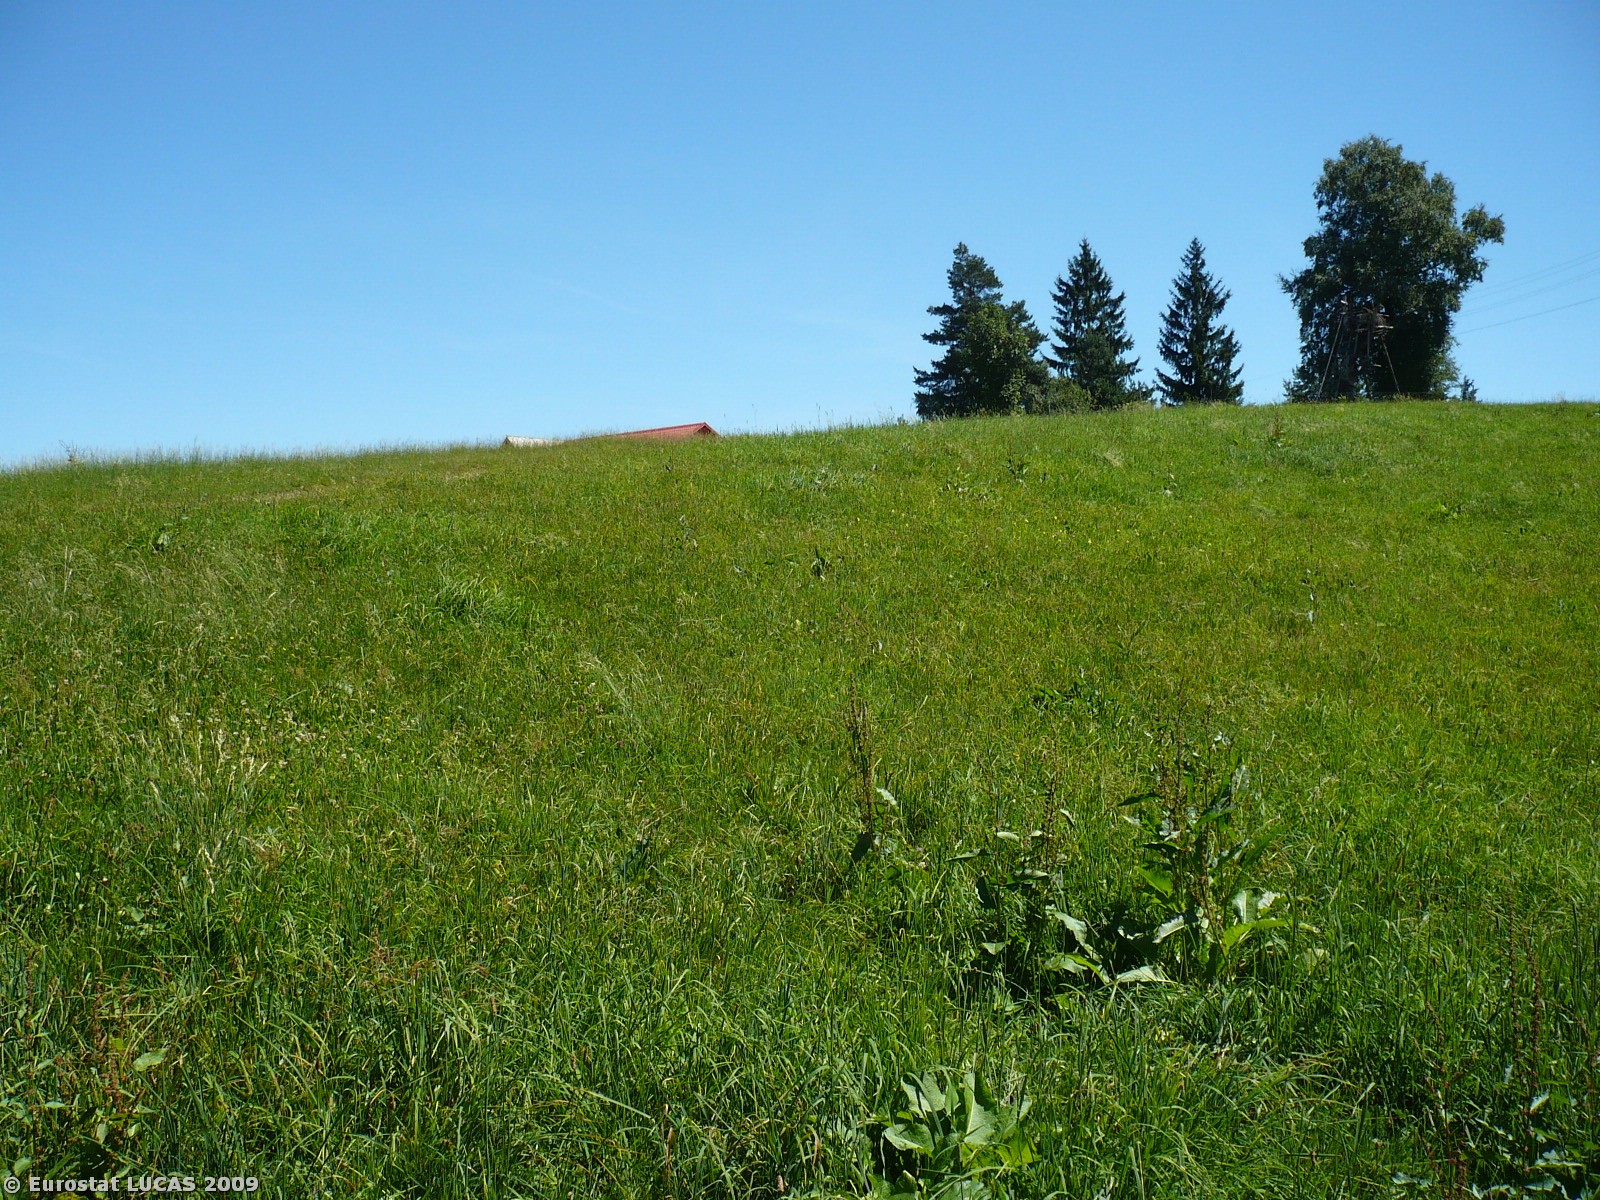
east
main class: Grassland
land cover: Grassland without tree/shrub cover
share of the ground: > 75 %
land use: Agriculture (excluding fallow land and kitchen gardens)
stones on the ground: 10 - 25 %
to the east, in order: Grassland without tree/shrub cover; Fences; Grassland without tree/shrub cover; Artificial constructions in urban areas; Grassland with sparse tree/shrub cover; Shrubland with sparse tree cover; Fences; Mixed woodland; Tracks; Mixed woodland; Fences; Mixed woodland
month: July
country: SI
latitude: 46.6508
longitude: 15.3429
